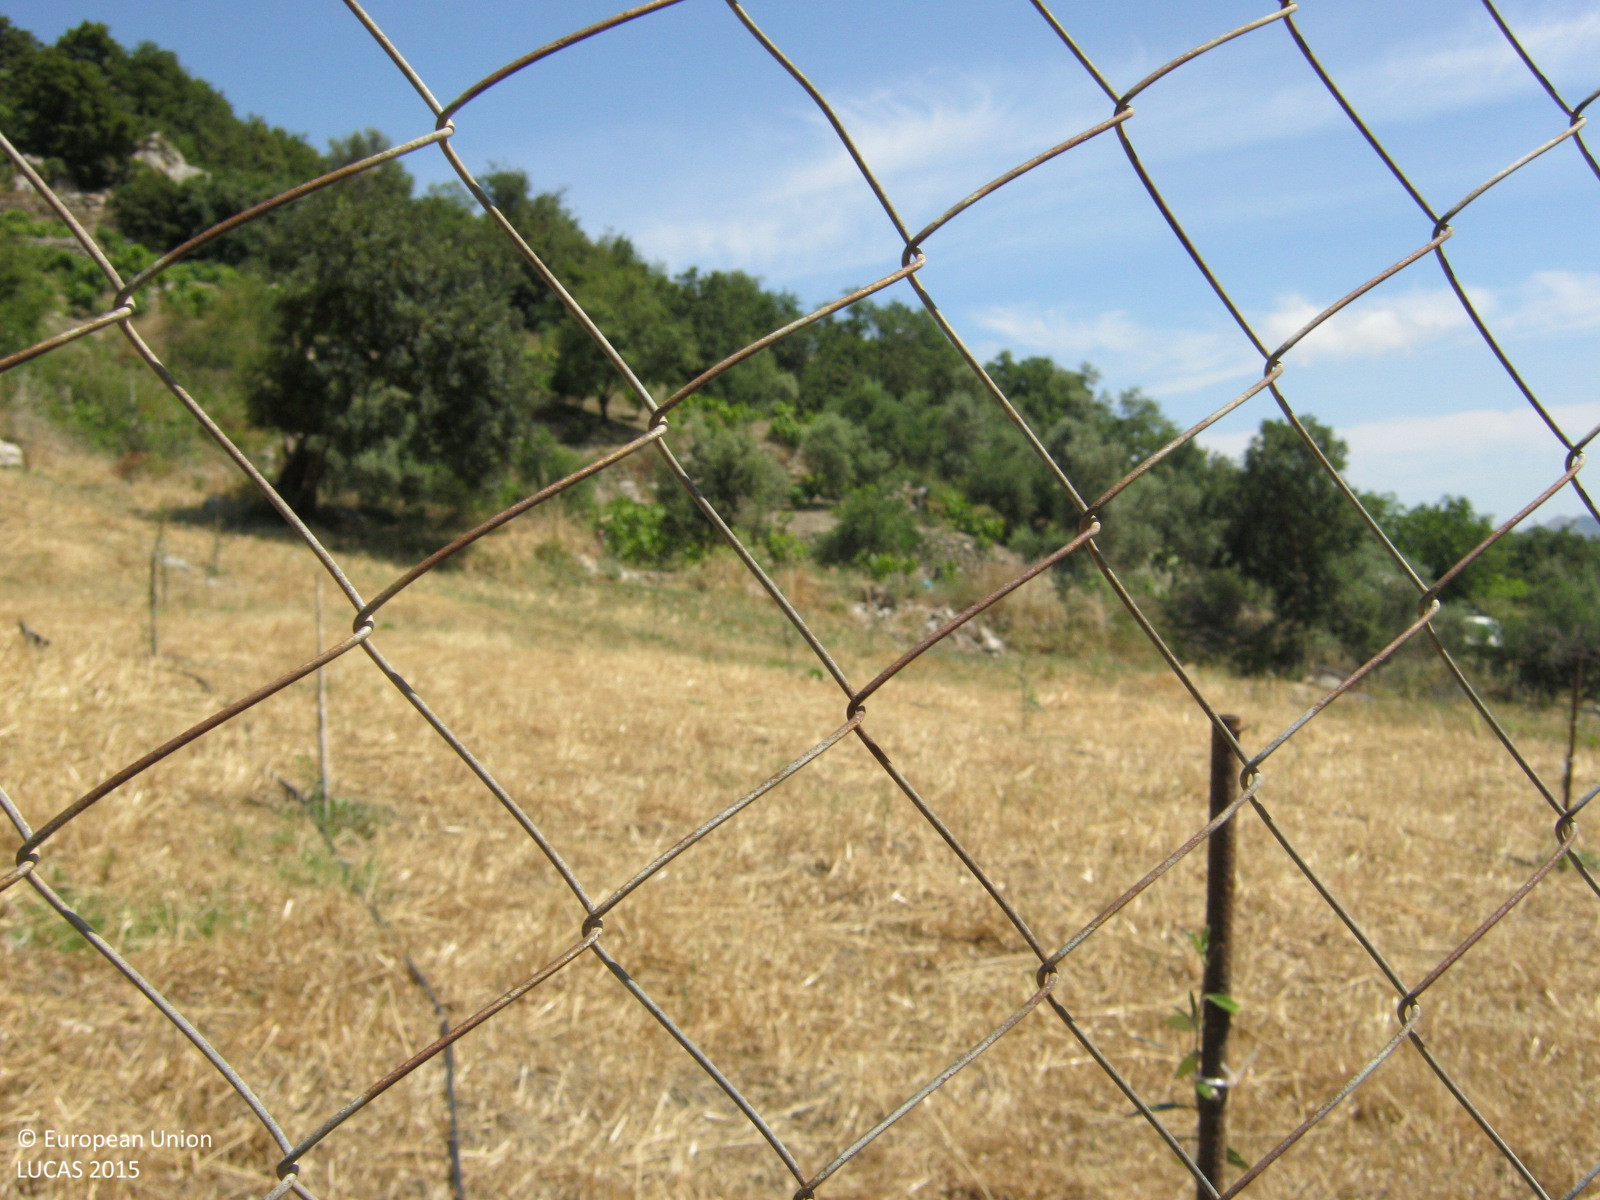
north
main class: Grassland
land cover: Grassland with sparse tree/shrub cover
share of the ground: > 75 %
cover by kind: herbaceous plants 95 %, broadleaved forest trees 5 %
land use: Agriculture (excluding fallow land and kitchen gardens)
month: June
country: GR
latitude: 35.3040
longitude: 24.8474
